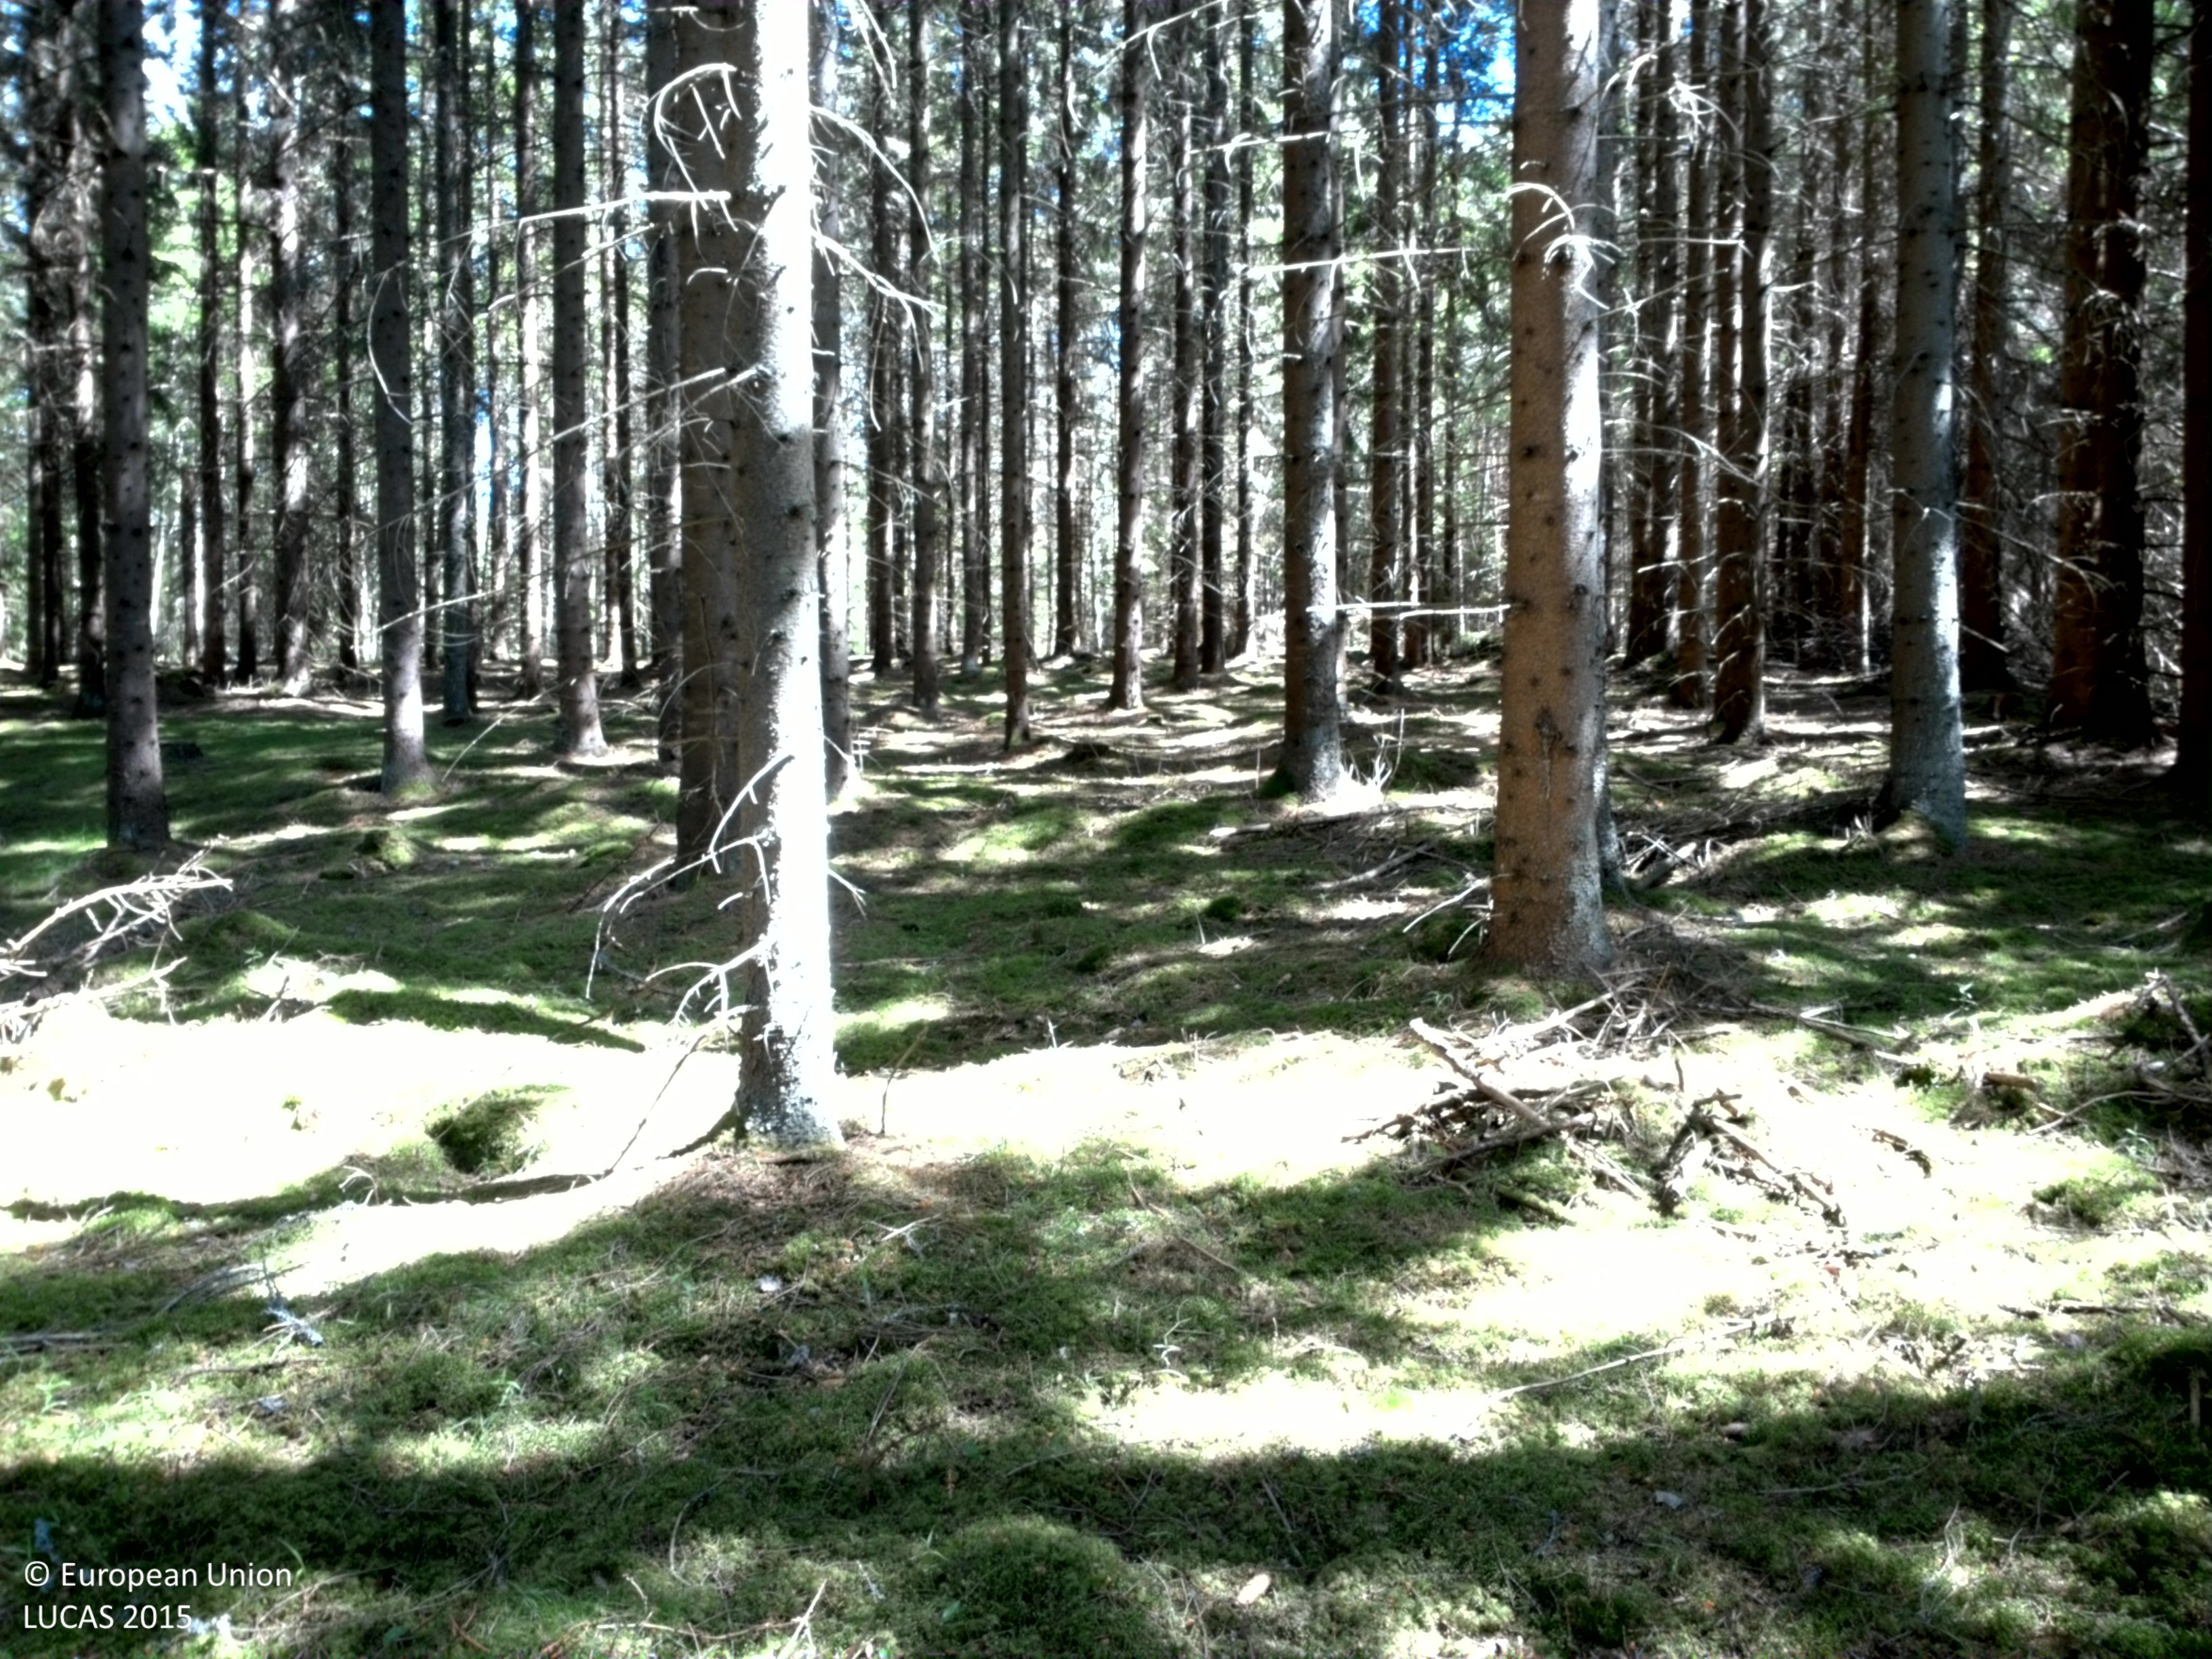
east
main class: Woodland
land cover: Spruce dominated coniferous woodland
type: boreal forest
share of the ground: 50 - 75 %
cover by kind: coniferous forest trees 75 %, lichens and mosses 25 %
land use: Forestry
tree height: > 5 m
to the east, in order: Spruce dominated coniferous woodland; Other mixed woodland; Pine dominated coniferous woodland; Paved roads, cycling and walking lanes; Pine dominated coniferous woodland; Pine dominated mixed woodland; Pine dominated coniferous woodland
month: June
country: SE
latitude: 58.5593
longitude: 14.4795
